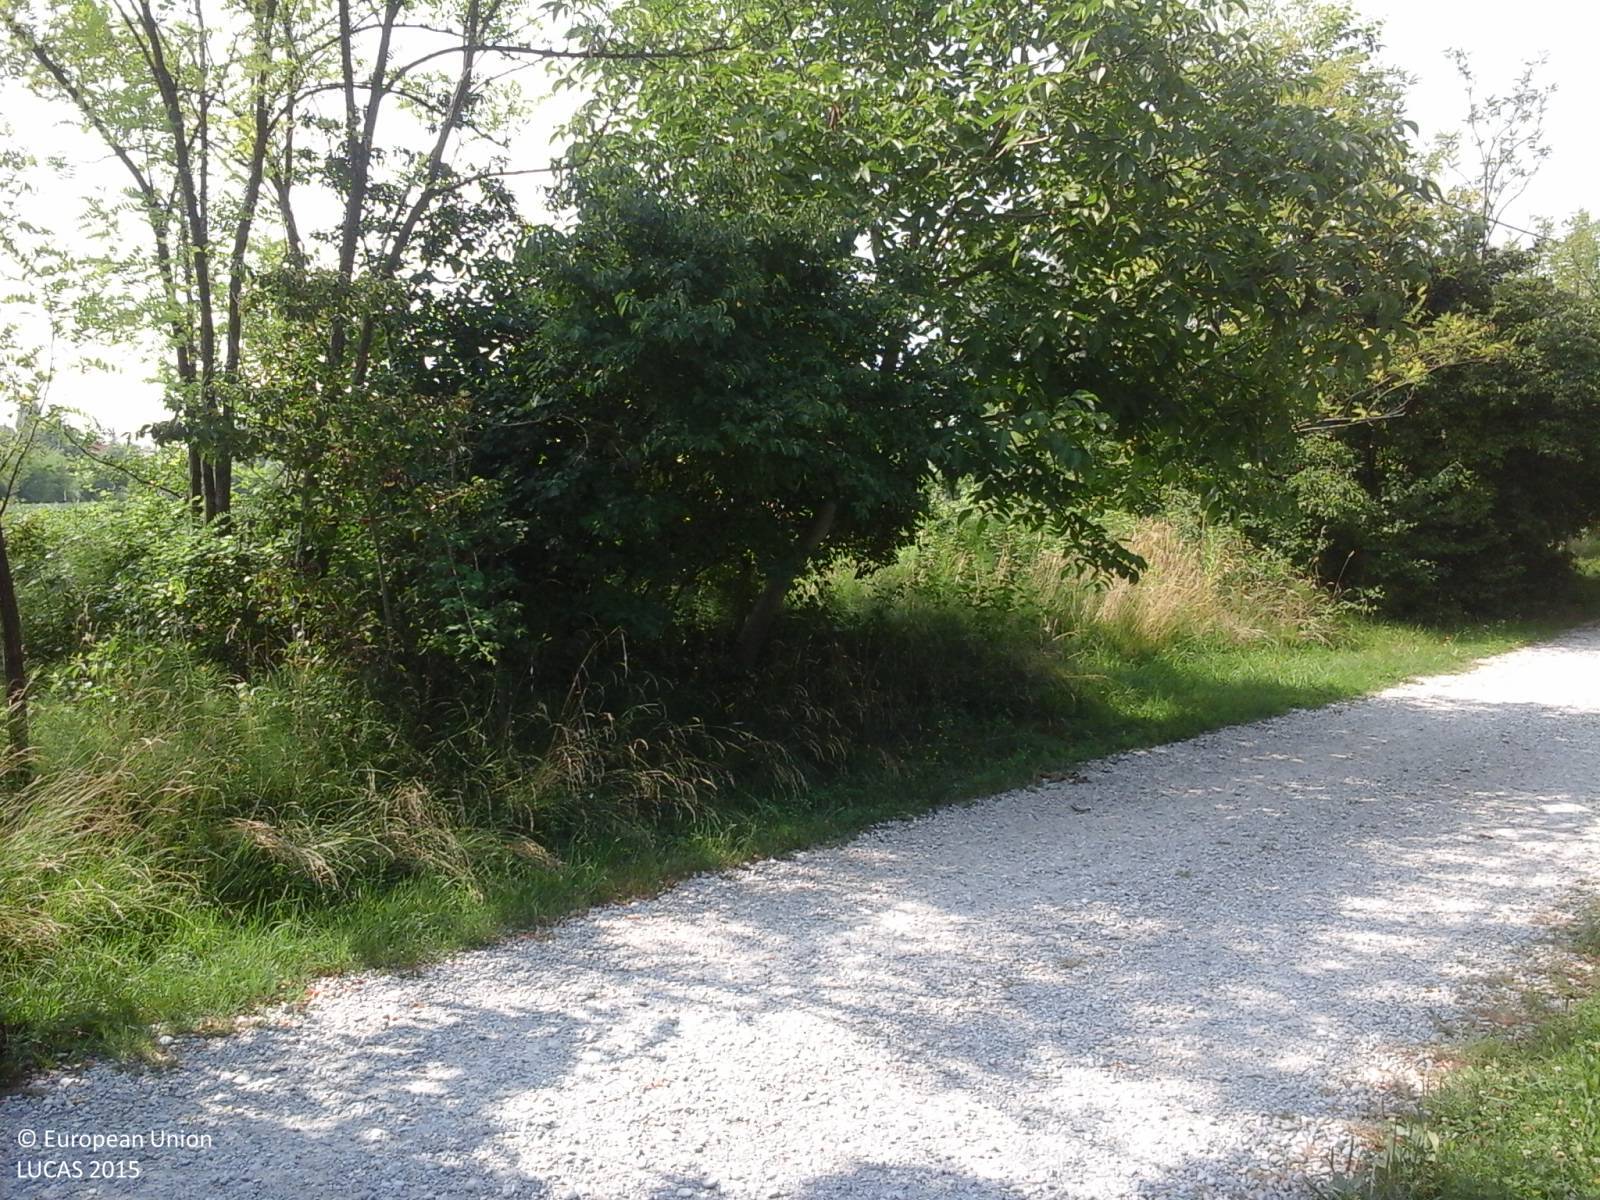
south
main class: Grassland
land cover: Grassland with sparse tree/shrub cover
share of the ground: > 75 %
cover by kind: herbaceous plants 85 %, shrubs 10 %, coniferous forest trees 5 %
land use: Residential
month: July
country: IT
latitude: 45.9568
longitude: 12.6932
